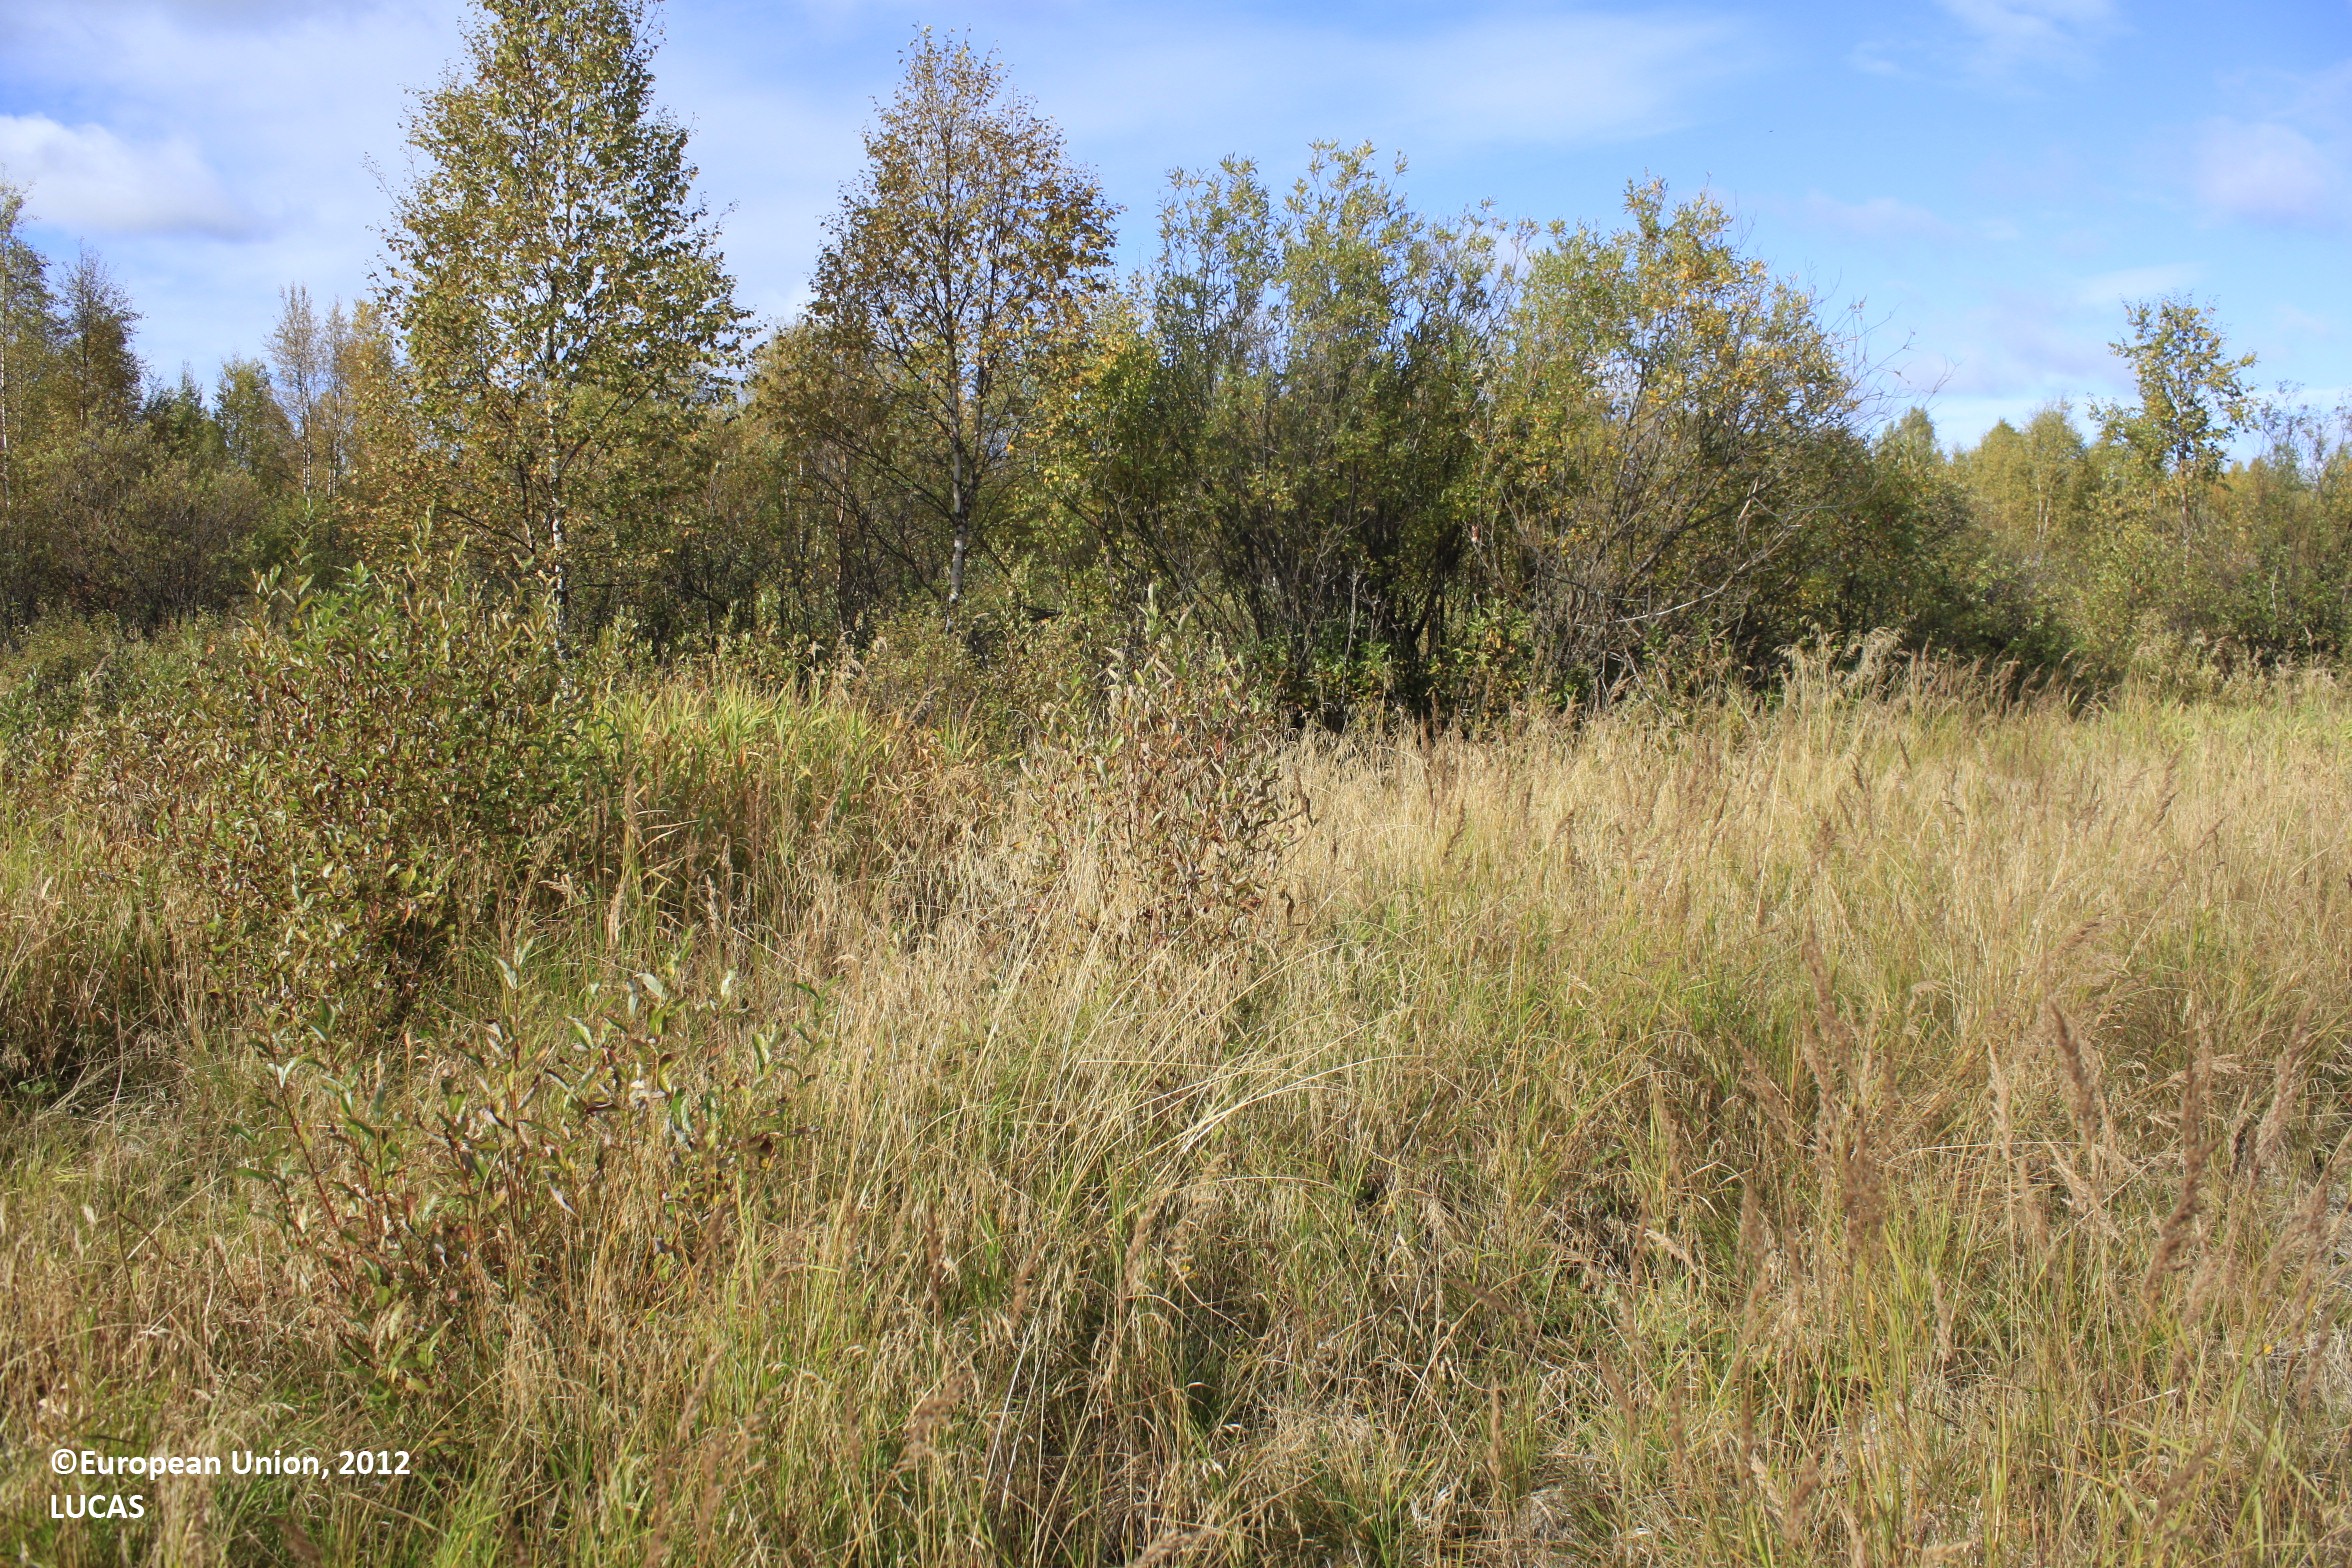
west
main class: Woodland
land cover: Broadleaved woodland
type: boreal forest
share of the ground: 25 - 50 %
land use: Forestry
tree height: < 5 m
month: September
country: FI
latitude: 65.6364
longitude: 26.5462
